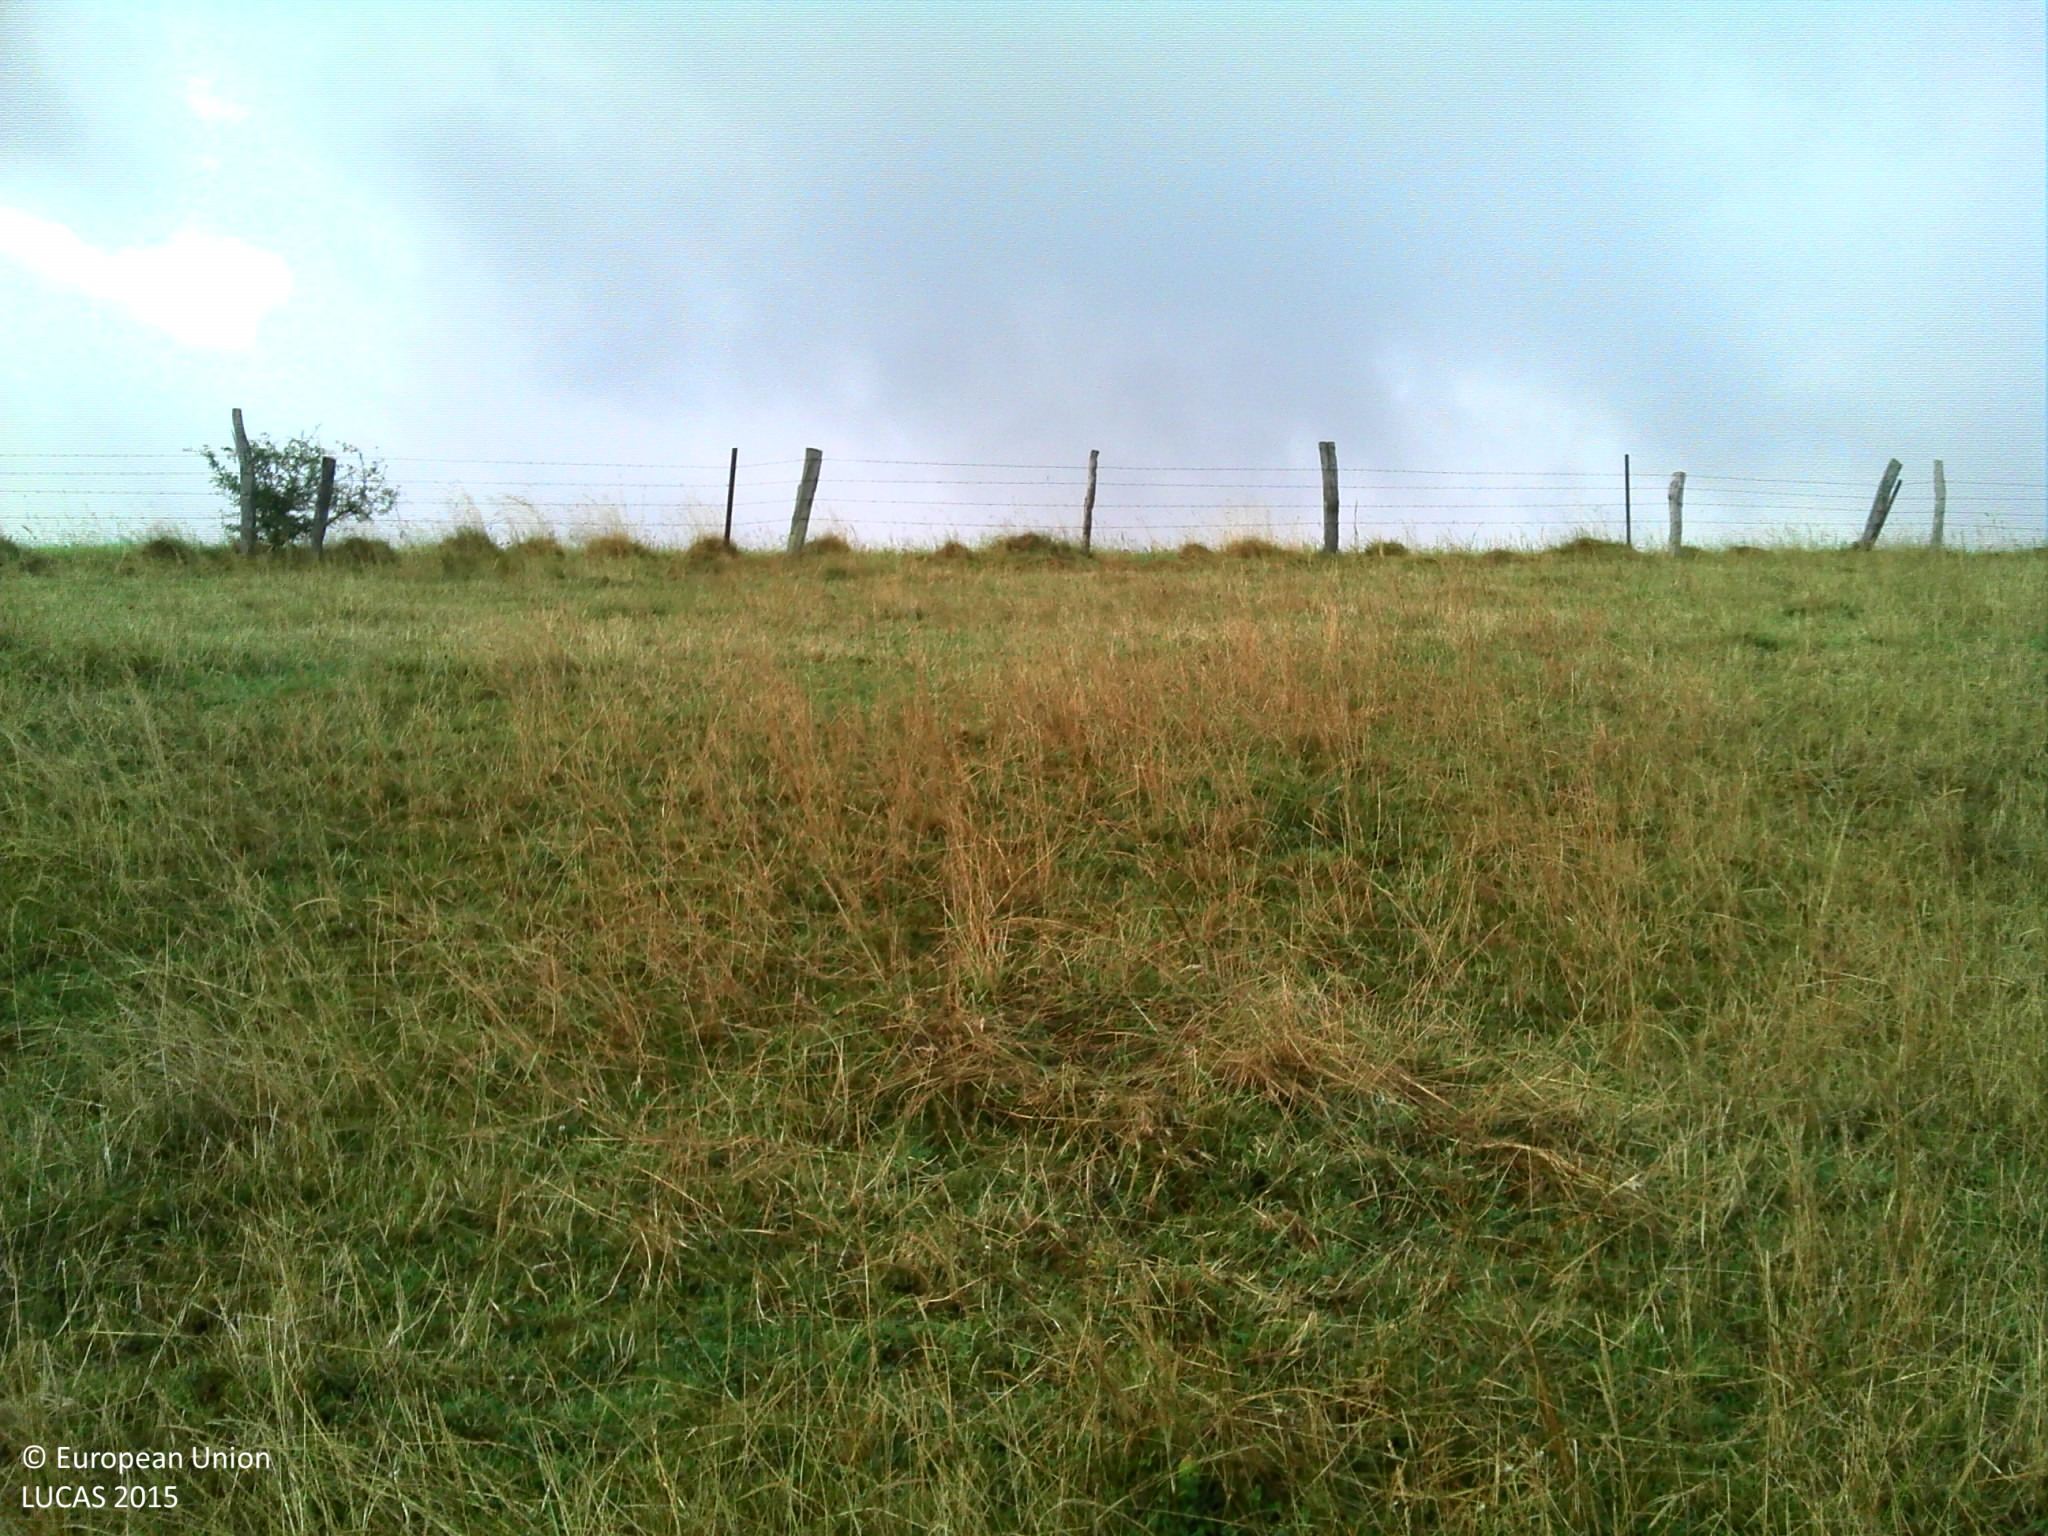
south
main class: Grassland
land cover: Grassland without tree/shrub cover
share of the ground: > 75 %
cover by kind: herbaceous plants 100 %
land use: Agriculture (excluding fallow land and kitchen gardens)
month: July
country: BE
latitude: 49.6019
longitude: 5.7787
